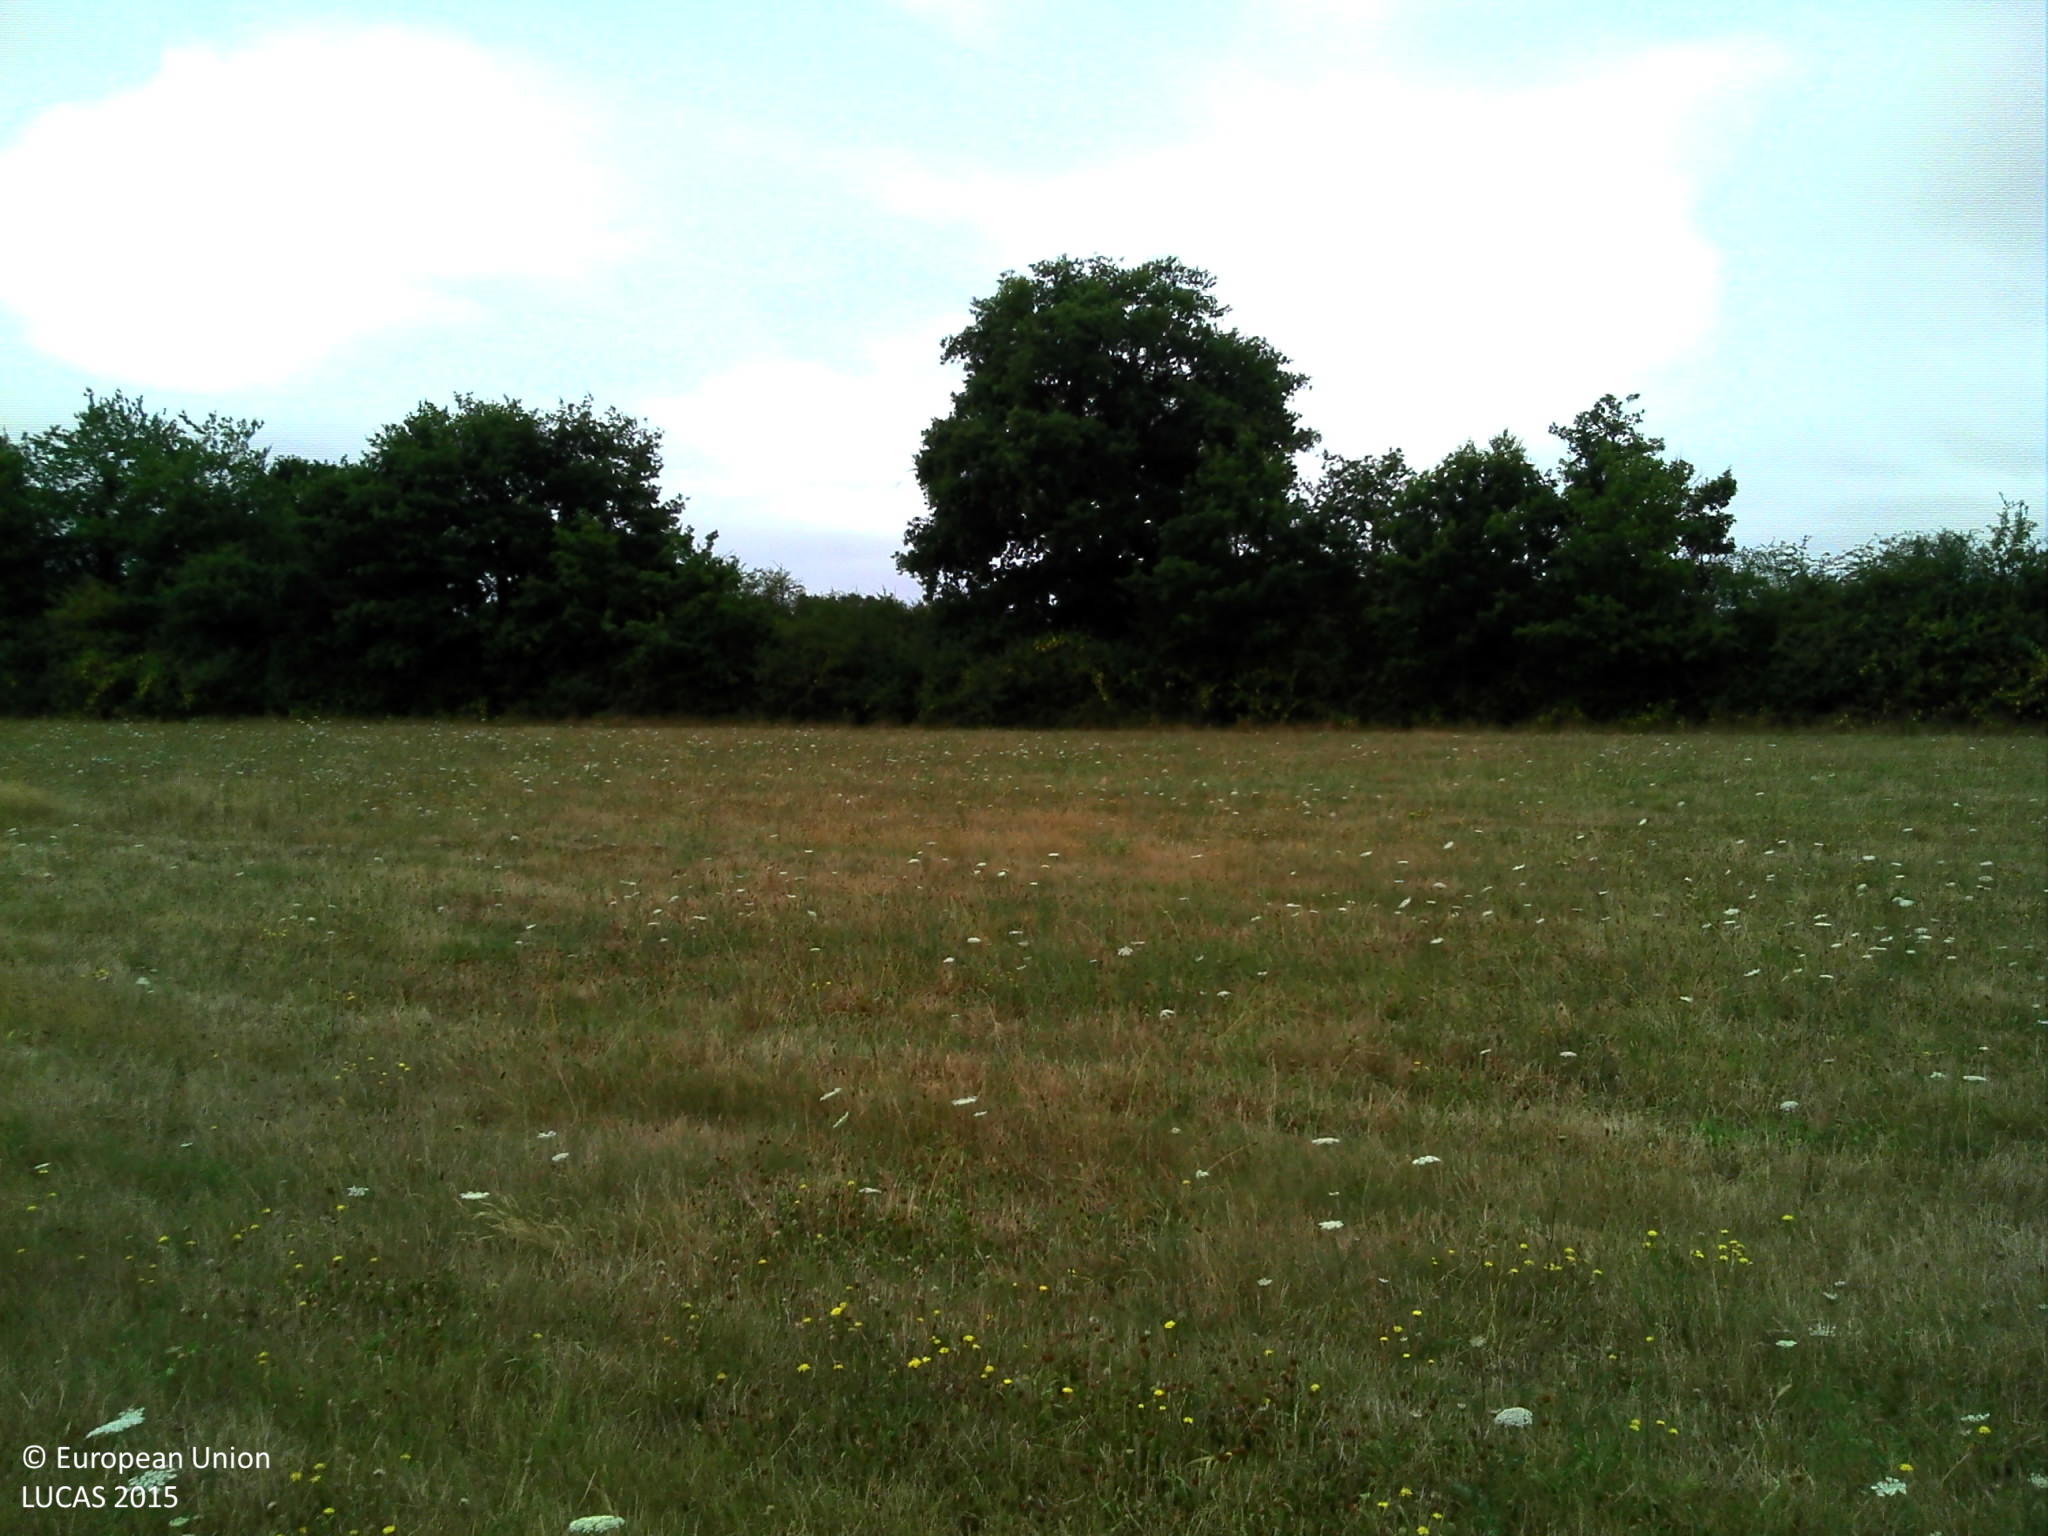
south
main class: Grassland
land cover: Grassland without tree/shrub cover
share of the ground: > 75 %
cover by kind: herbaceous plants 100 %
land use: Agriculture (excluding fallow land and kitchen gardens)
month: July
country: FR
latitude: 46.2631
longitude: 0.6042
